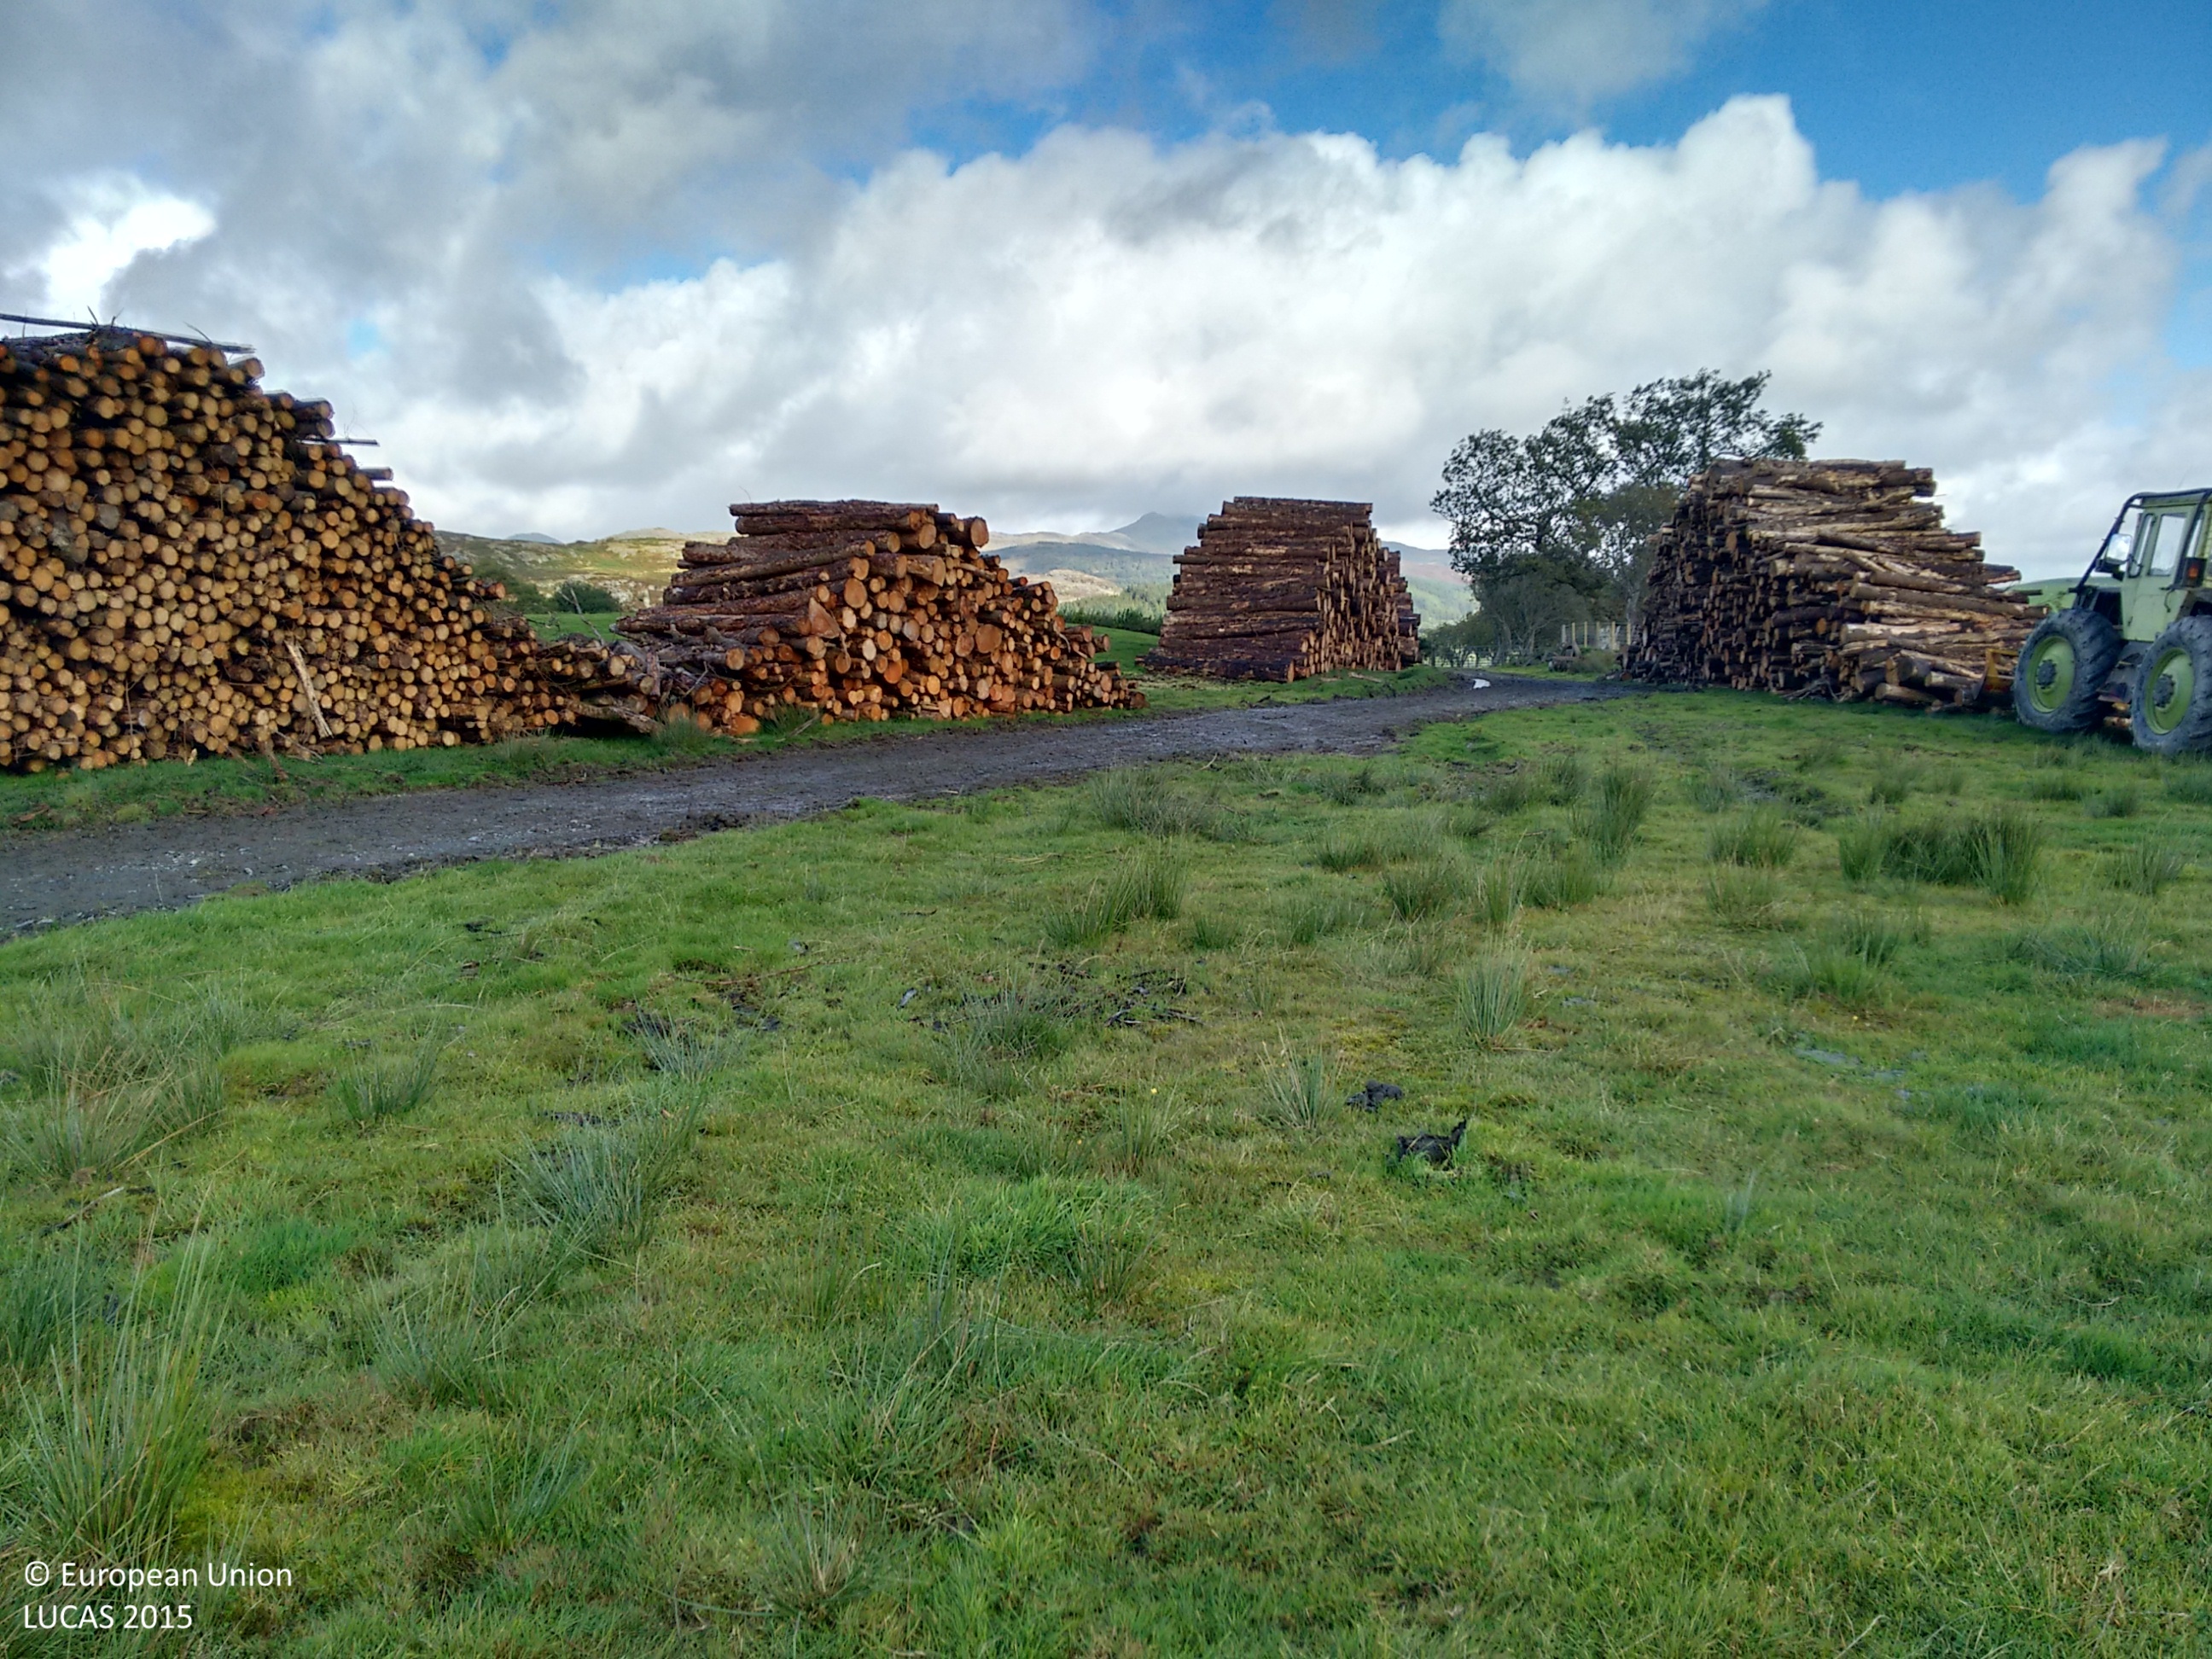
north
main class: Grassland
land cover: Grassland without tree/shrub cover
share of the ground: > 75 %
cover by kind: herbaceous plants 100 %
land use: Agriculture (excluding fallow land and kitchen gardens)
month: September
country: GB
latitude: 52.8548
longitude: -3.7065
